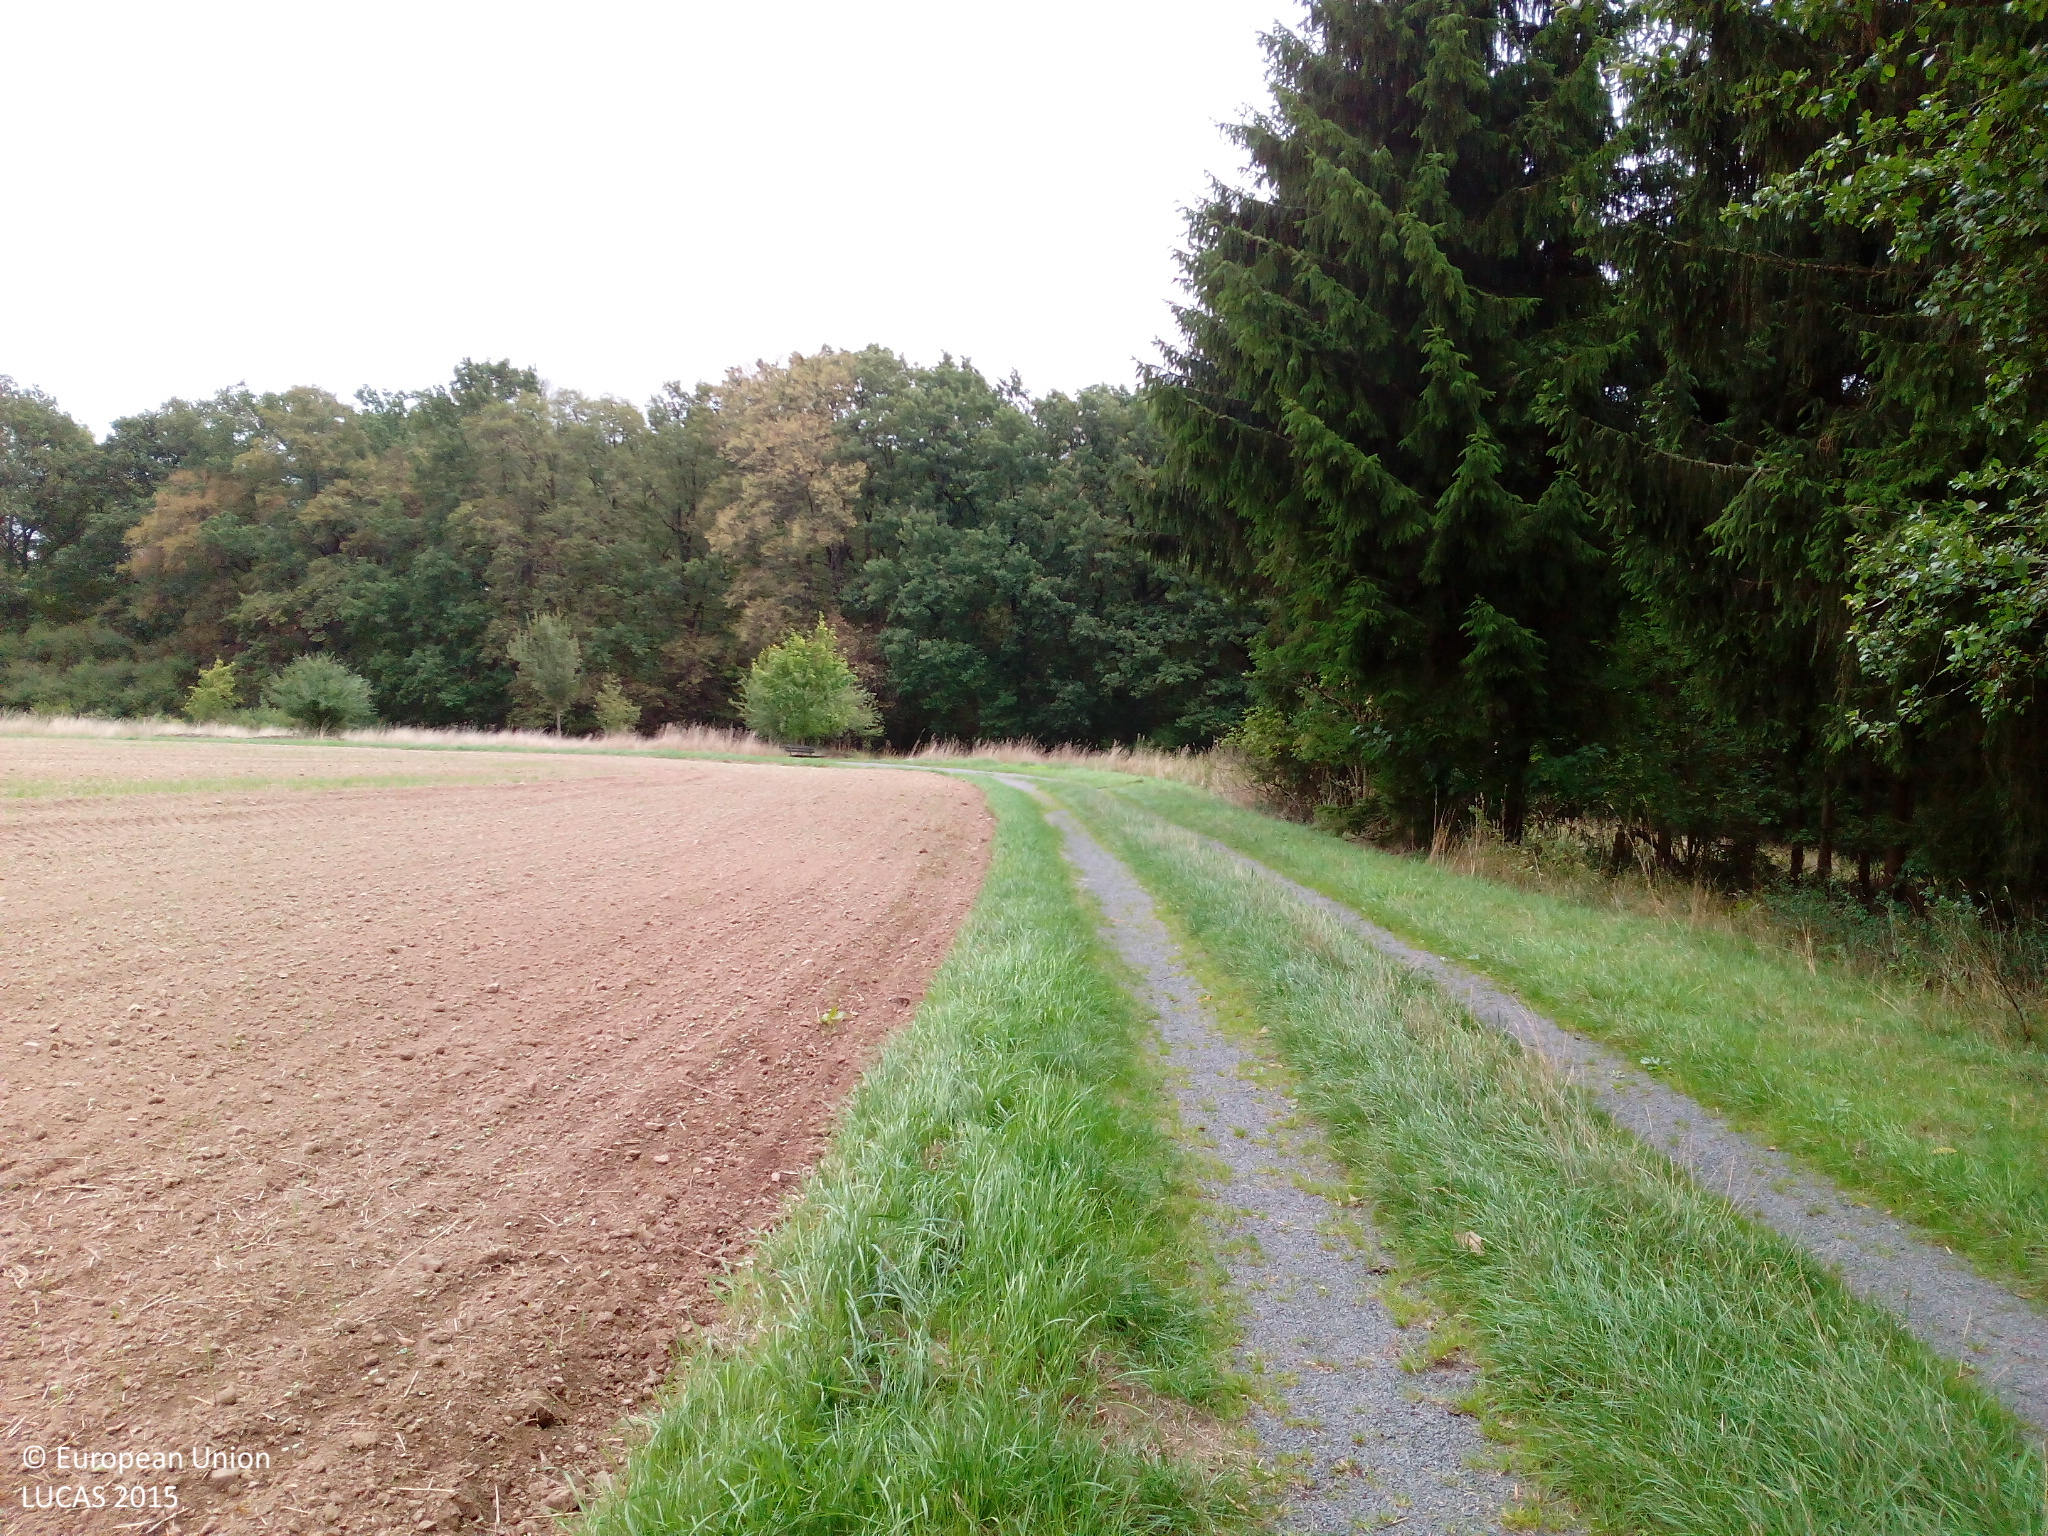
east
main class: Cropland
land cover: Common wheat
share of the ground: < 10 %
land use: Agriculture (excluding fallow land and kitchen gardens)
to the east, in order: Tracks; Spruce dominated coniferous woodland; Grassland without tree/shrub cover; Broadleaved woodland; Tracks; Broadleaved woodland
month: September
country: DE
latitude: 49.8237
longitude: 9.5692
